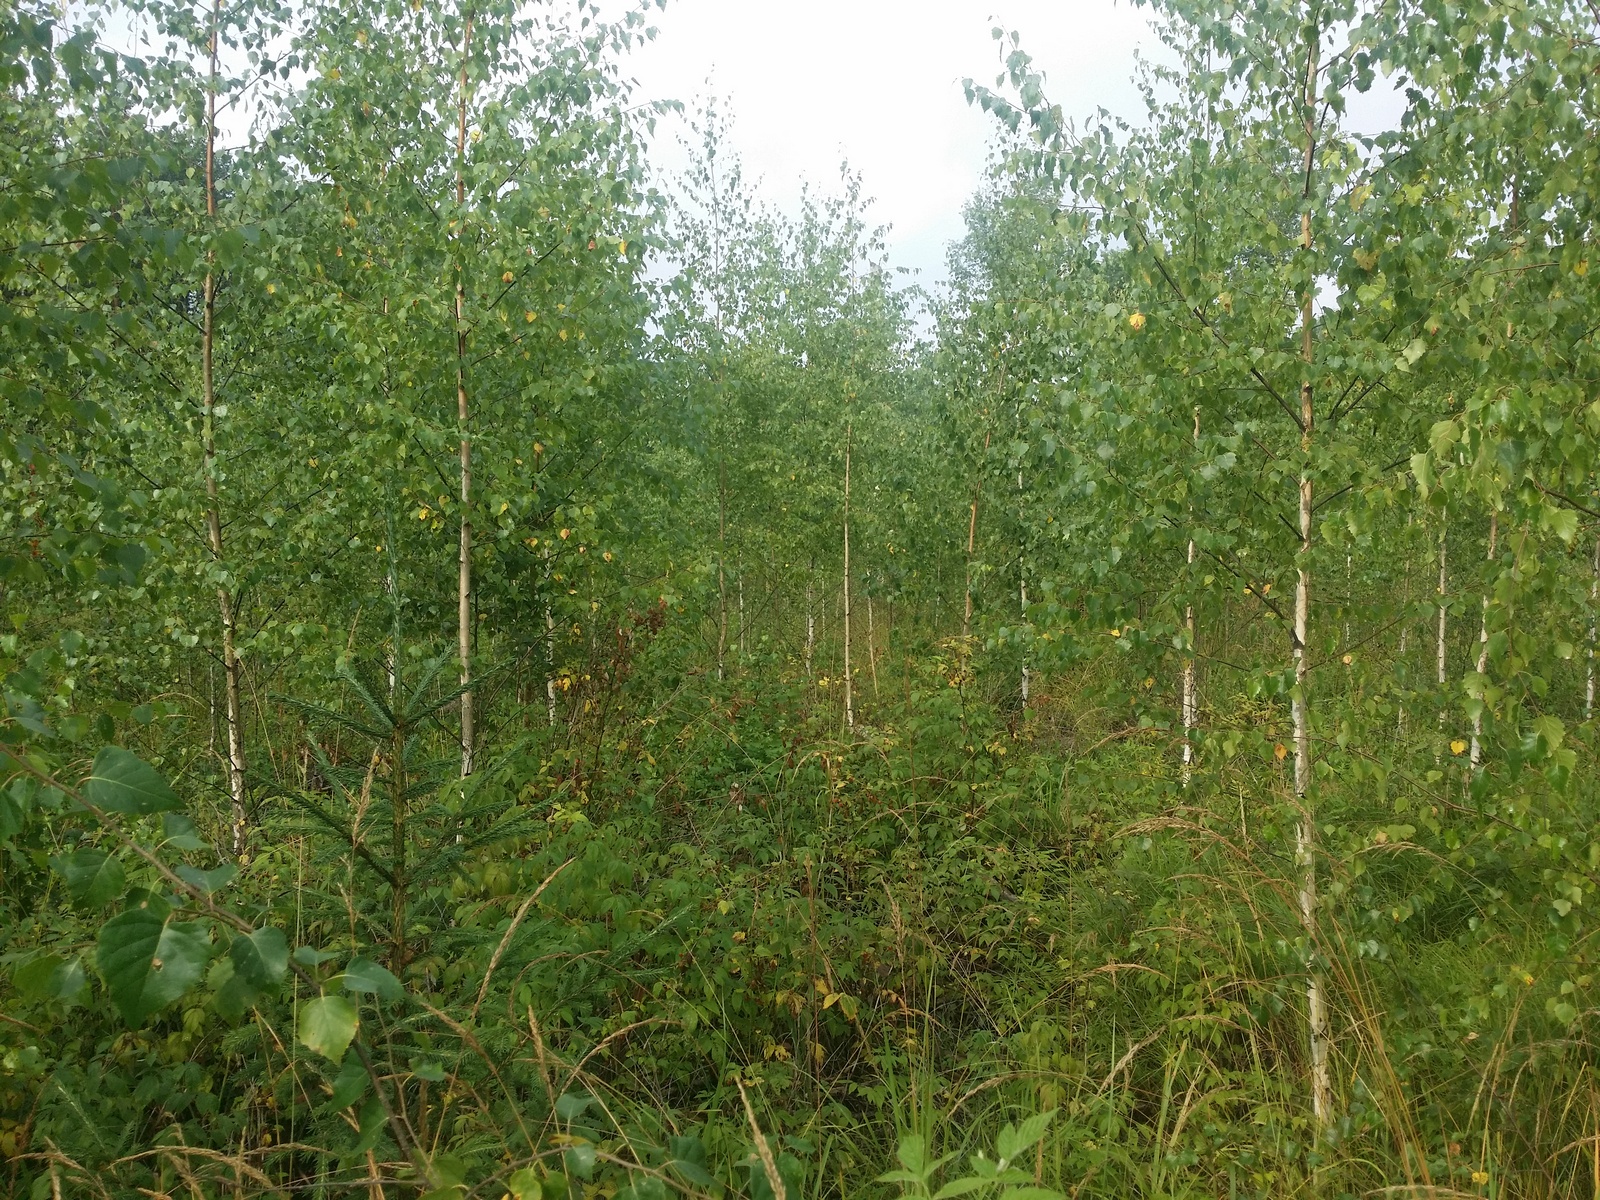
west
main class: Woodland
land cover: Broadleaved woodland
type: non-riverine alder, birch or aspen forest
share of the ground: 50 - 75 %
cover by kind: broadleaved forest trees 70 %, shrubs 20 %, herbaceous plants 10 %
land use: Forestry
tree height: < 5 m
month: August
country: LV
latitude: 57.4827
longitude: 26.5052
